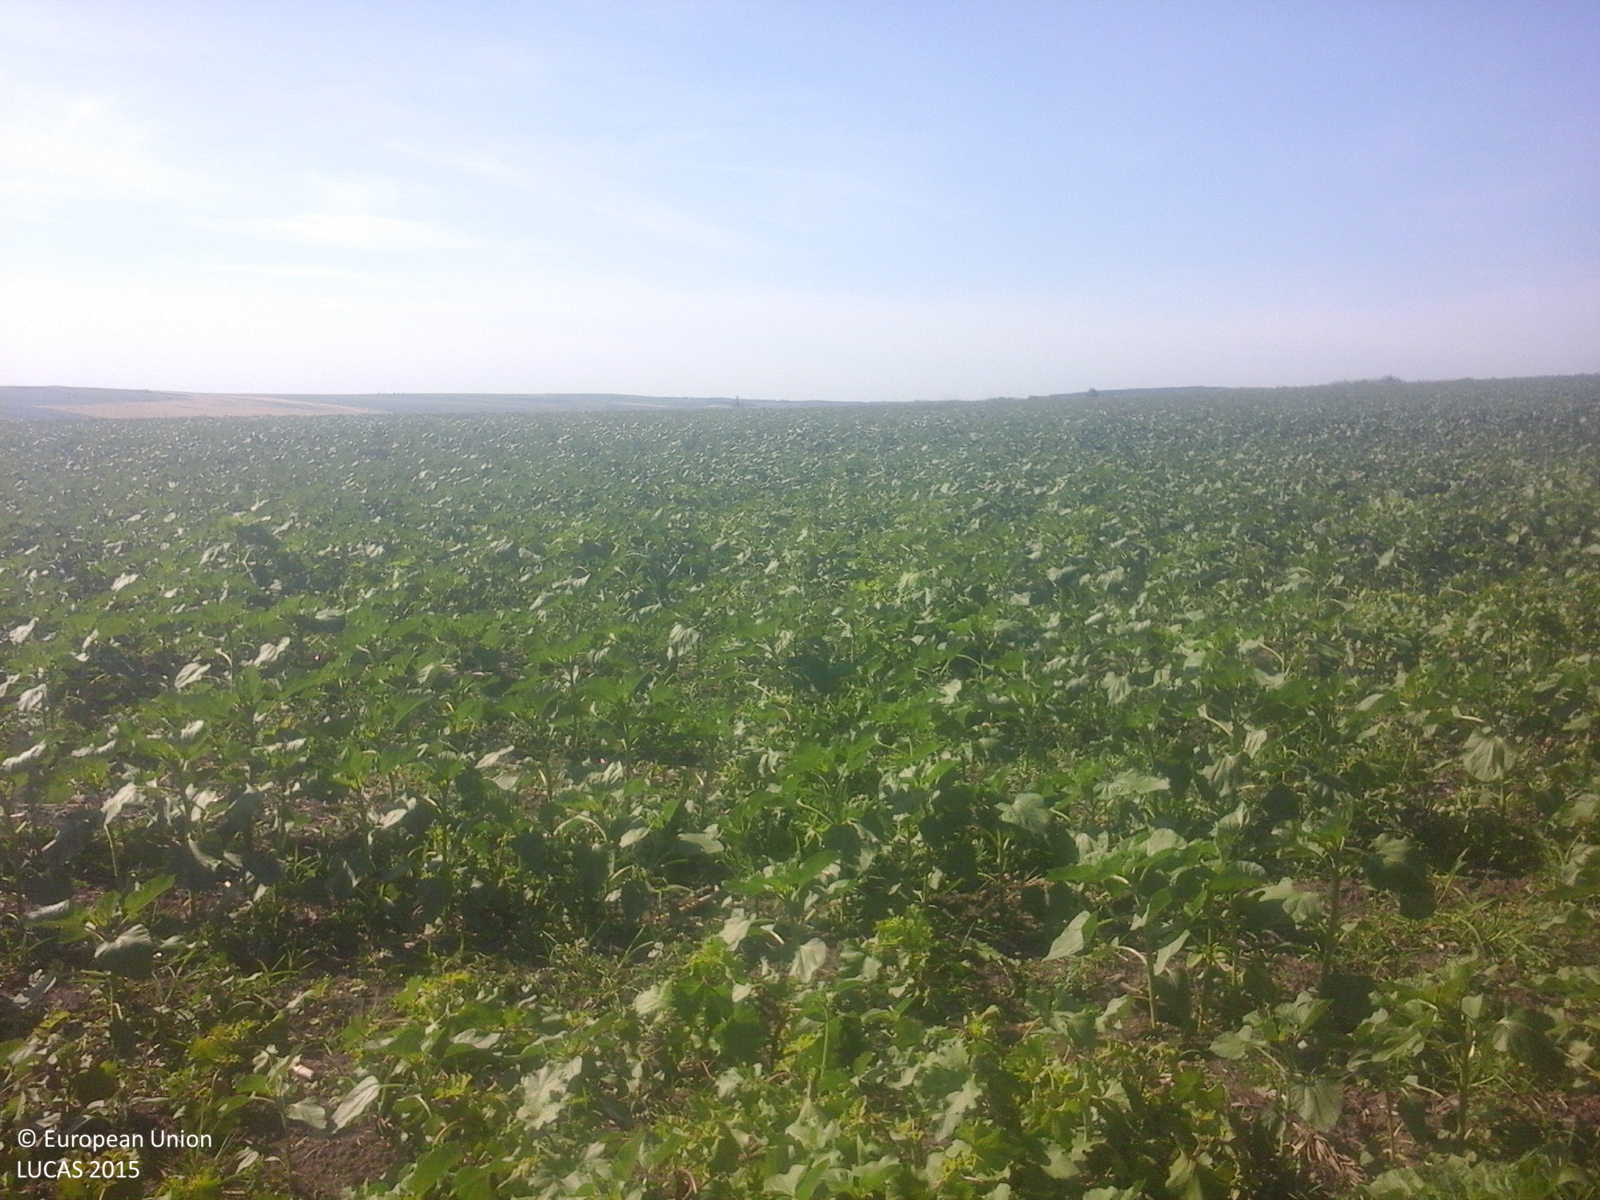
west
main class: Cropland
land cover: Sunflower
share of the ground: 50 - 75 %
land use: Agriculture (excluding fallow land and kitchen gardens)
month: June
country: RO
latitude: 47.9577
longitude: 26.9929
